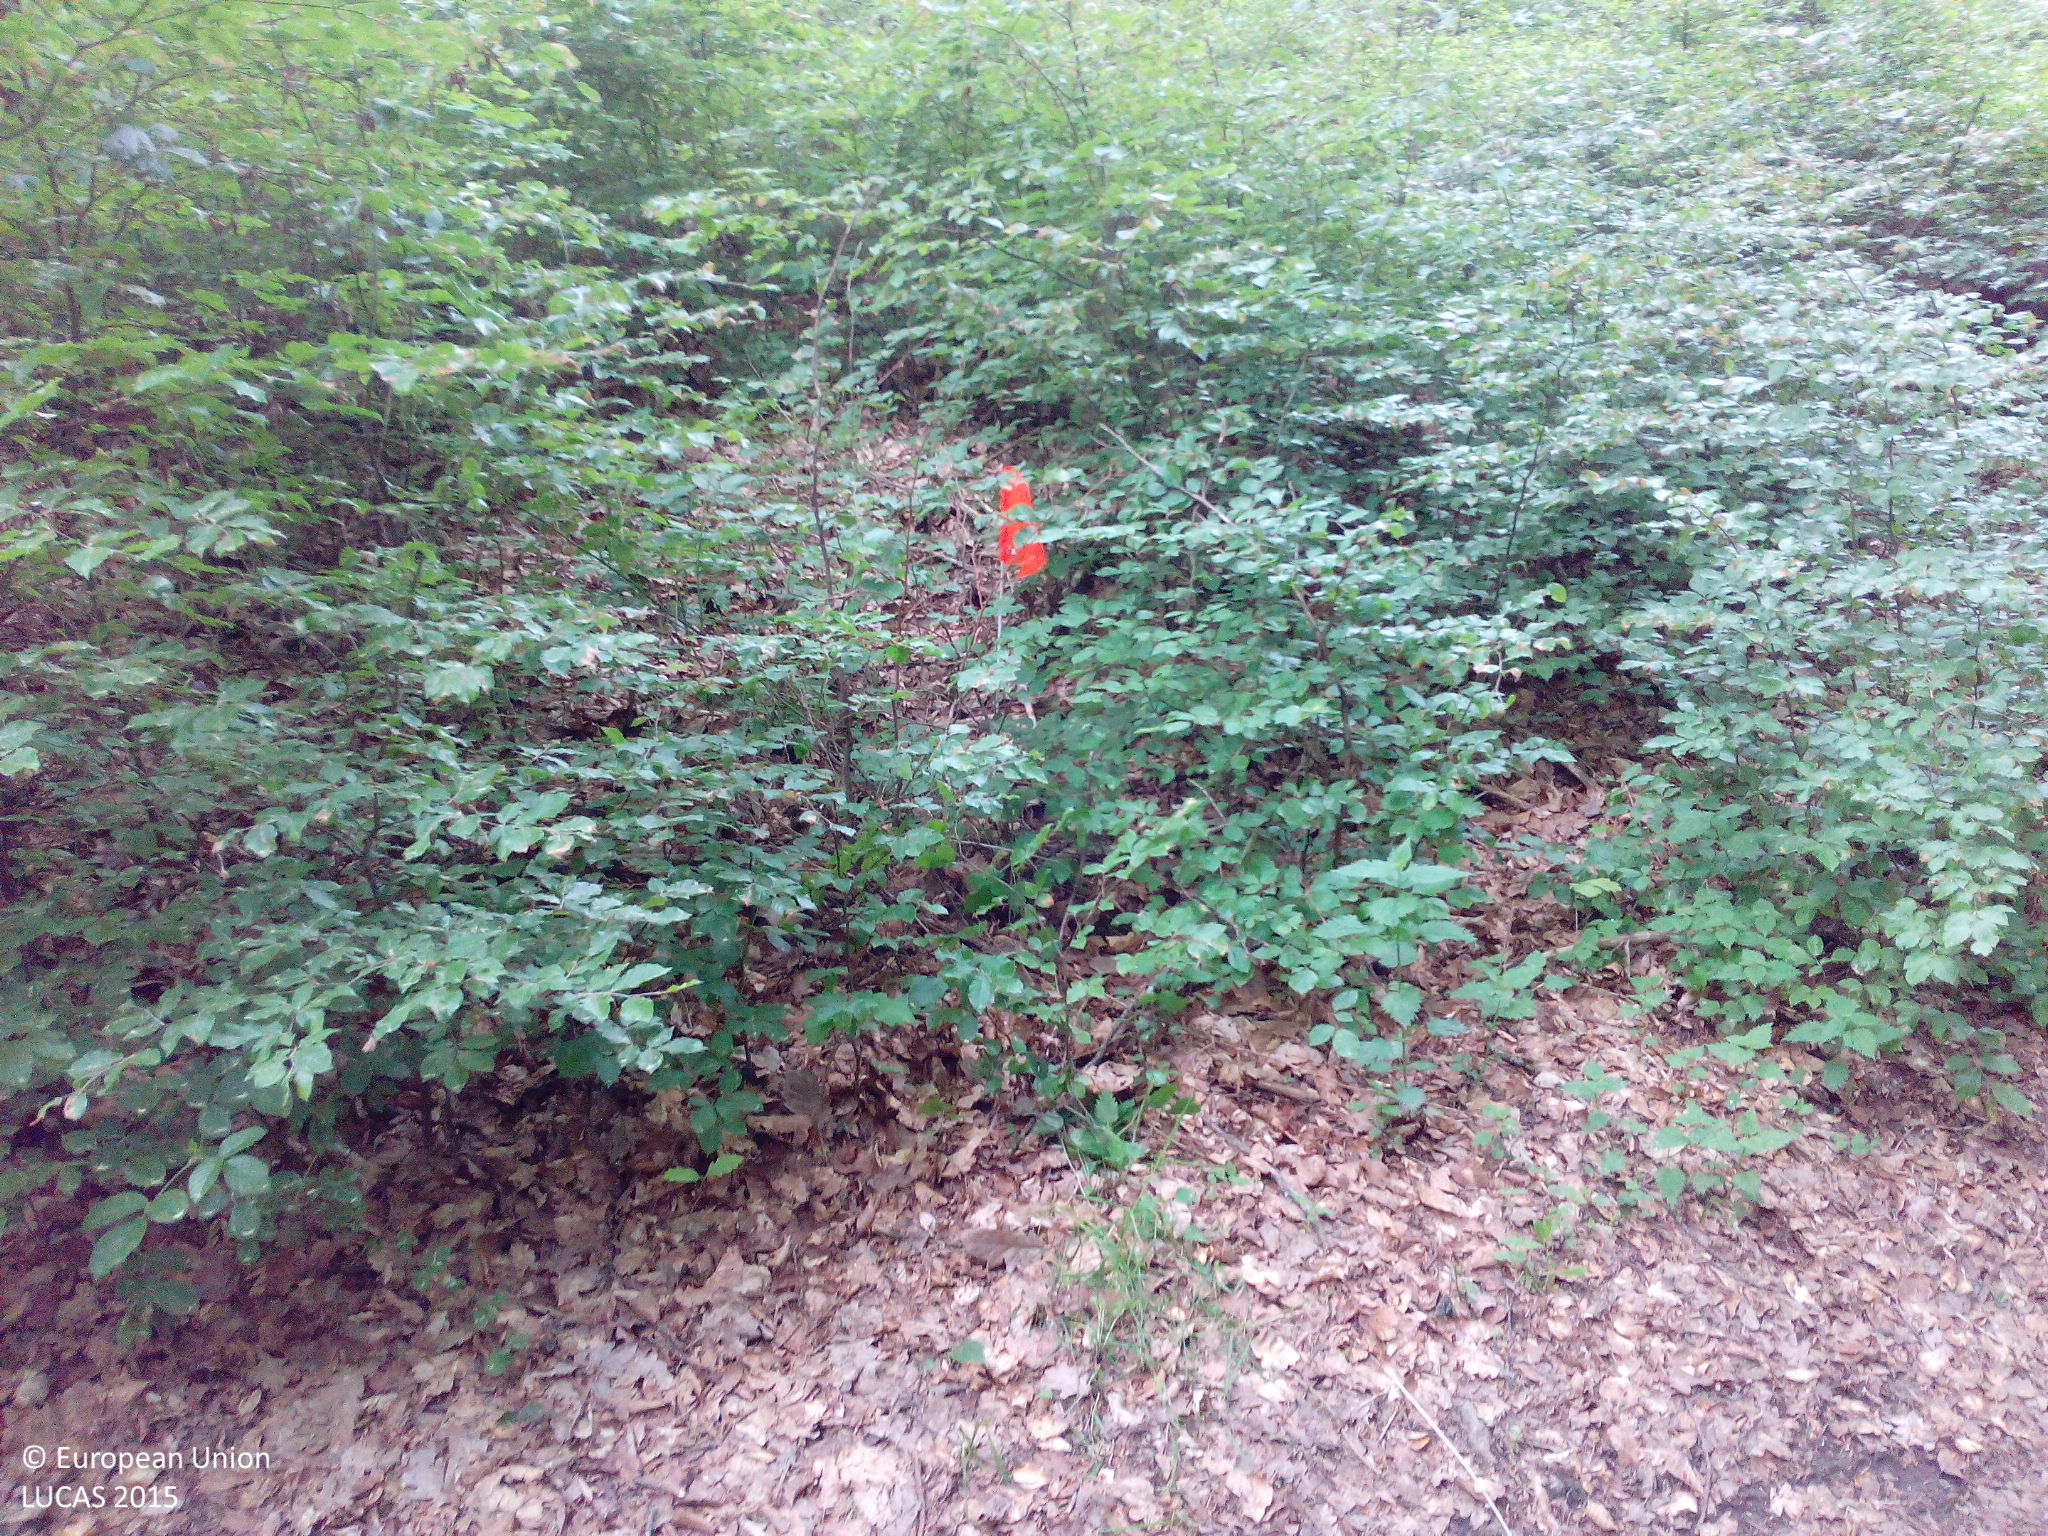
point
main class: Woodland
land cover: Spruce dominated mixed woodland
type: hemiboreal forest and nemoral coniferous forest and mixed broadleaved-coniferous forest
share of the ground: > 75 %
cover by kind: coniferous forest trees 50 %, broadleaved forest trees 30 %, unconsolidated bare surface 15 %, shrubs 5 %
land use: Forestry
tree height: > 5 m
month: May
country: DE
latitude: 49.1784
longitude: 11.9337
